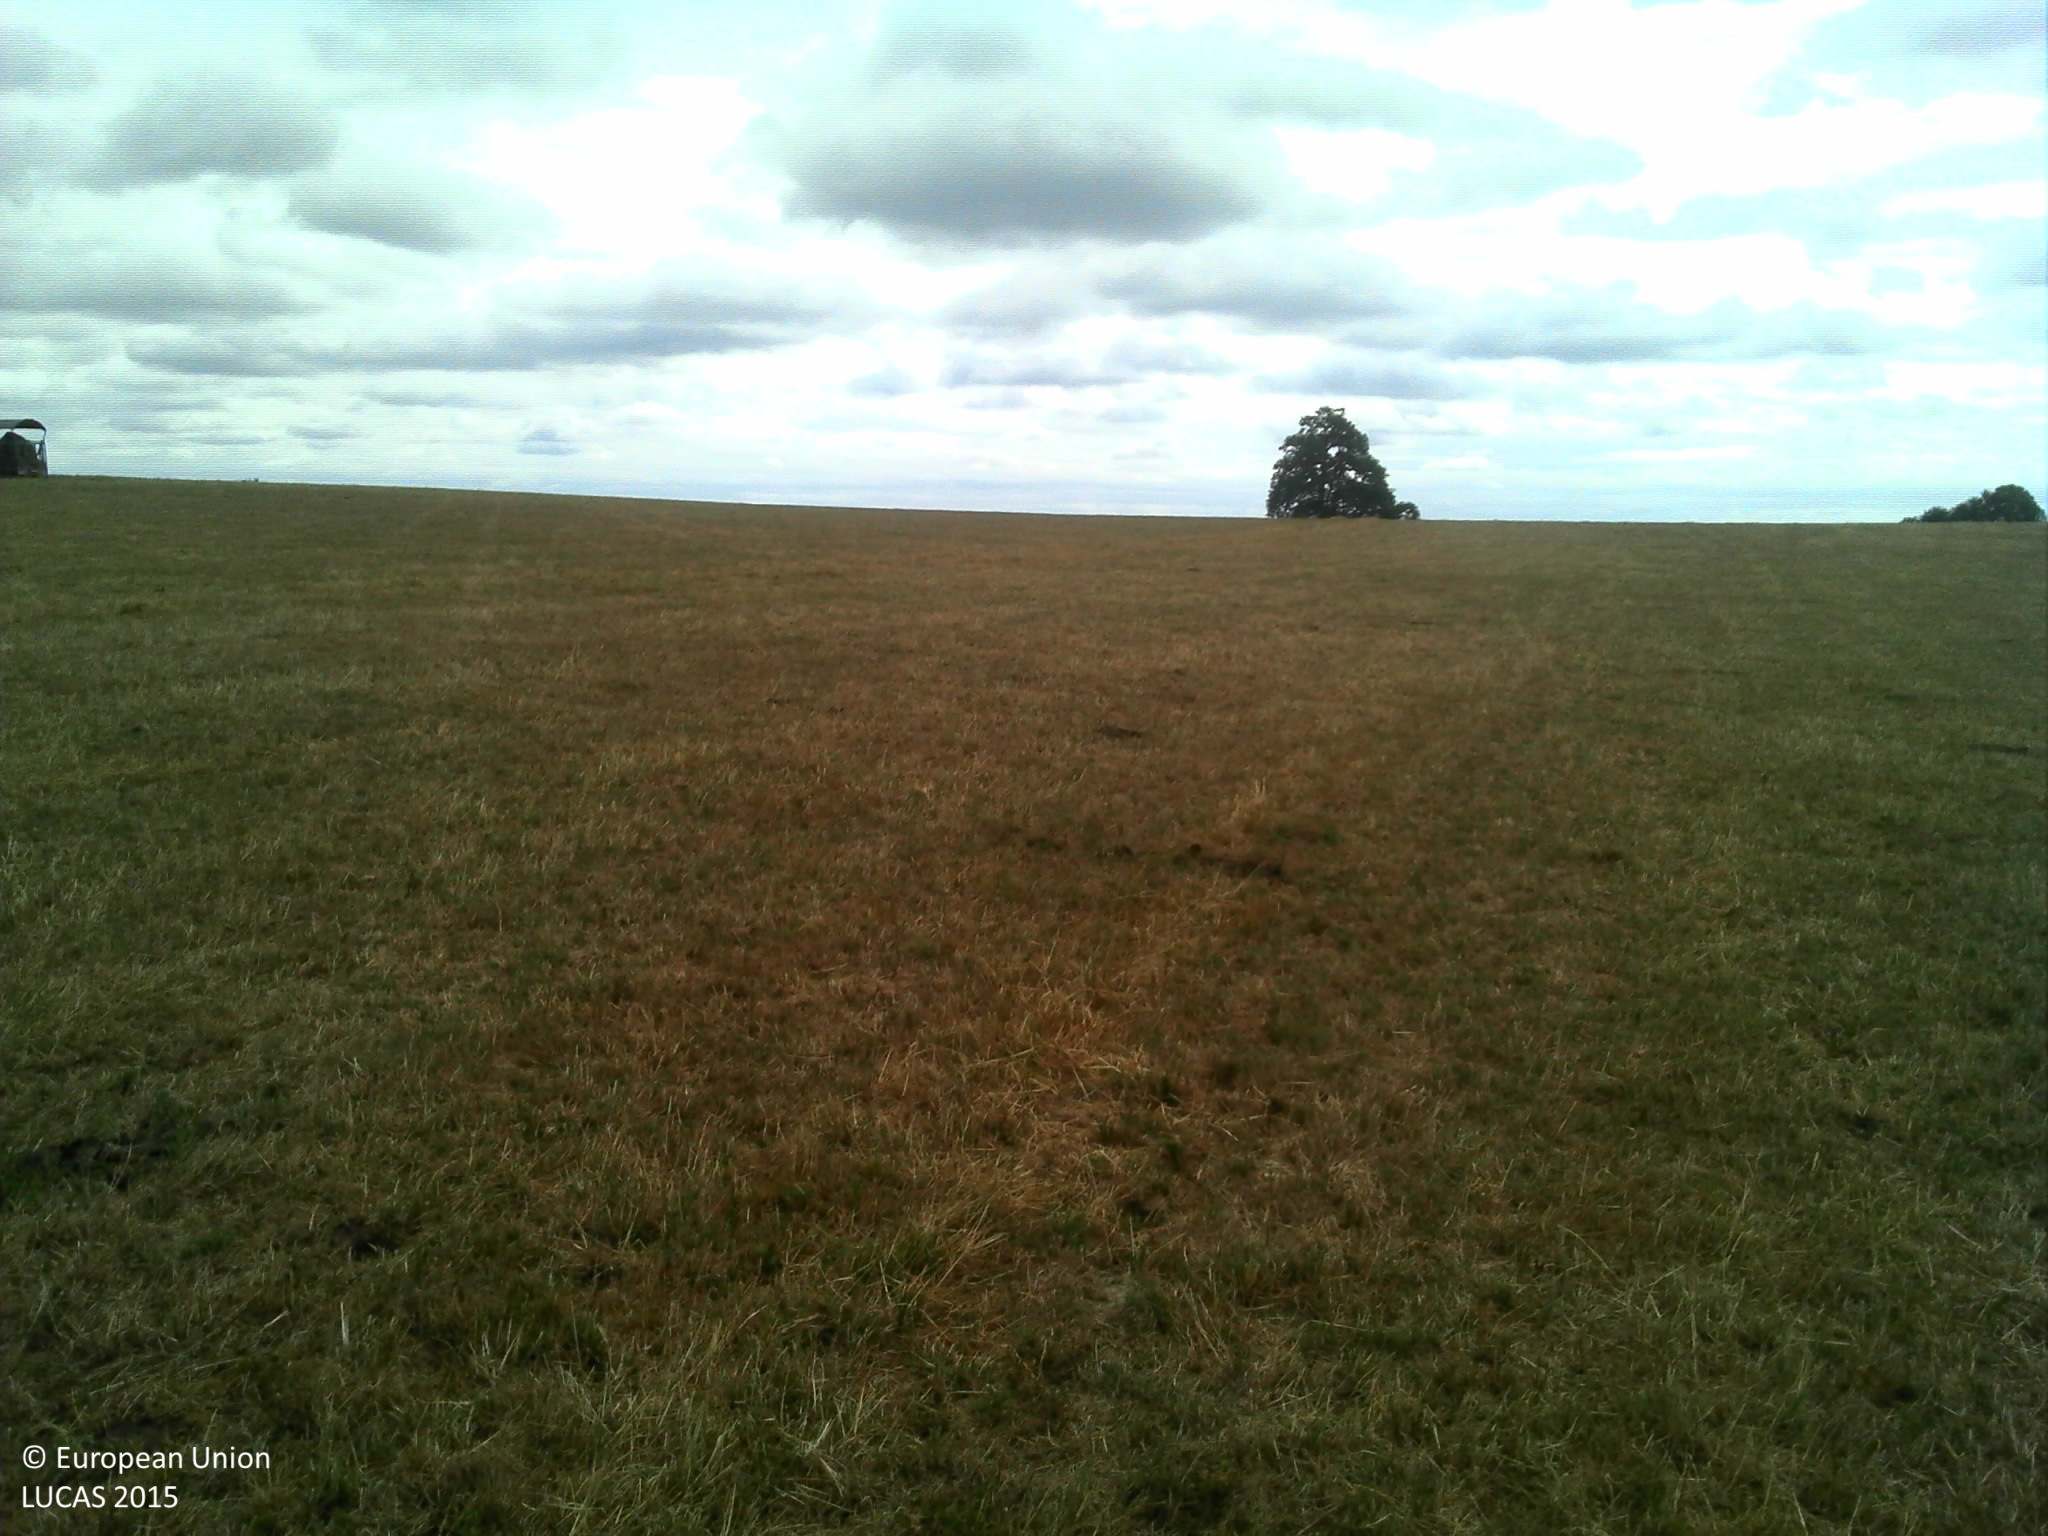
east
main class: Grassland
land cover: Grassland without tree/shrub cover
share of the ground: > 75 %
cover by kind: herbaceous plants 95 %
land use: Agriculture (excluding fallow land and kitchen gardens)
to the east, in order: Grassland without tree/shrub cover; Fences; Ditches and canals; Grass margins; Paved roads, cycling and walking lanes; Grass margins; Ditches and canals; Electric lines; Fences; Grassland without tree/shrub cover
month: July
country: FR
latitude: 45.4736
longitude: 1.3328
